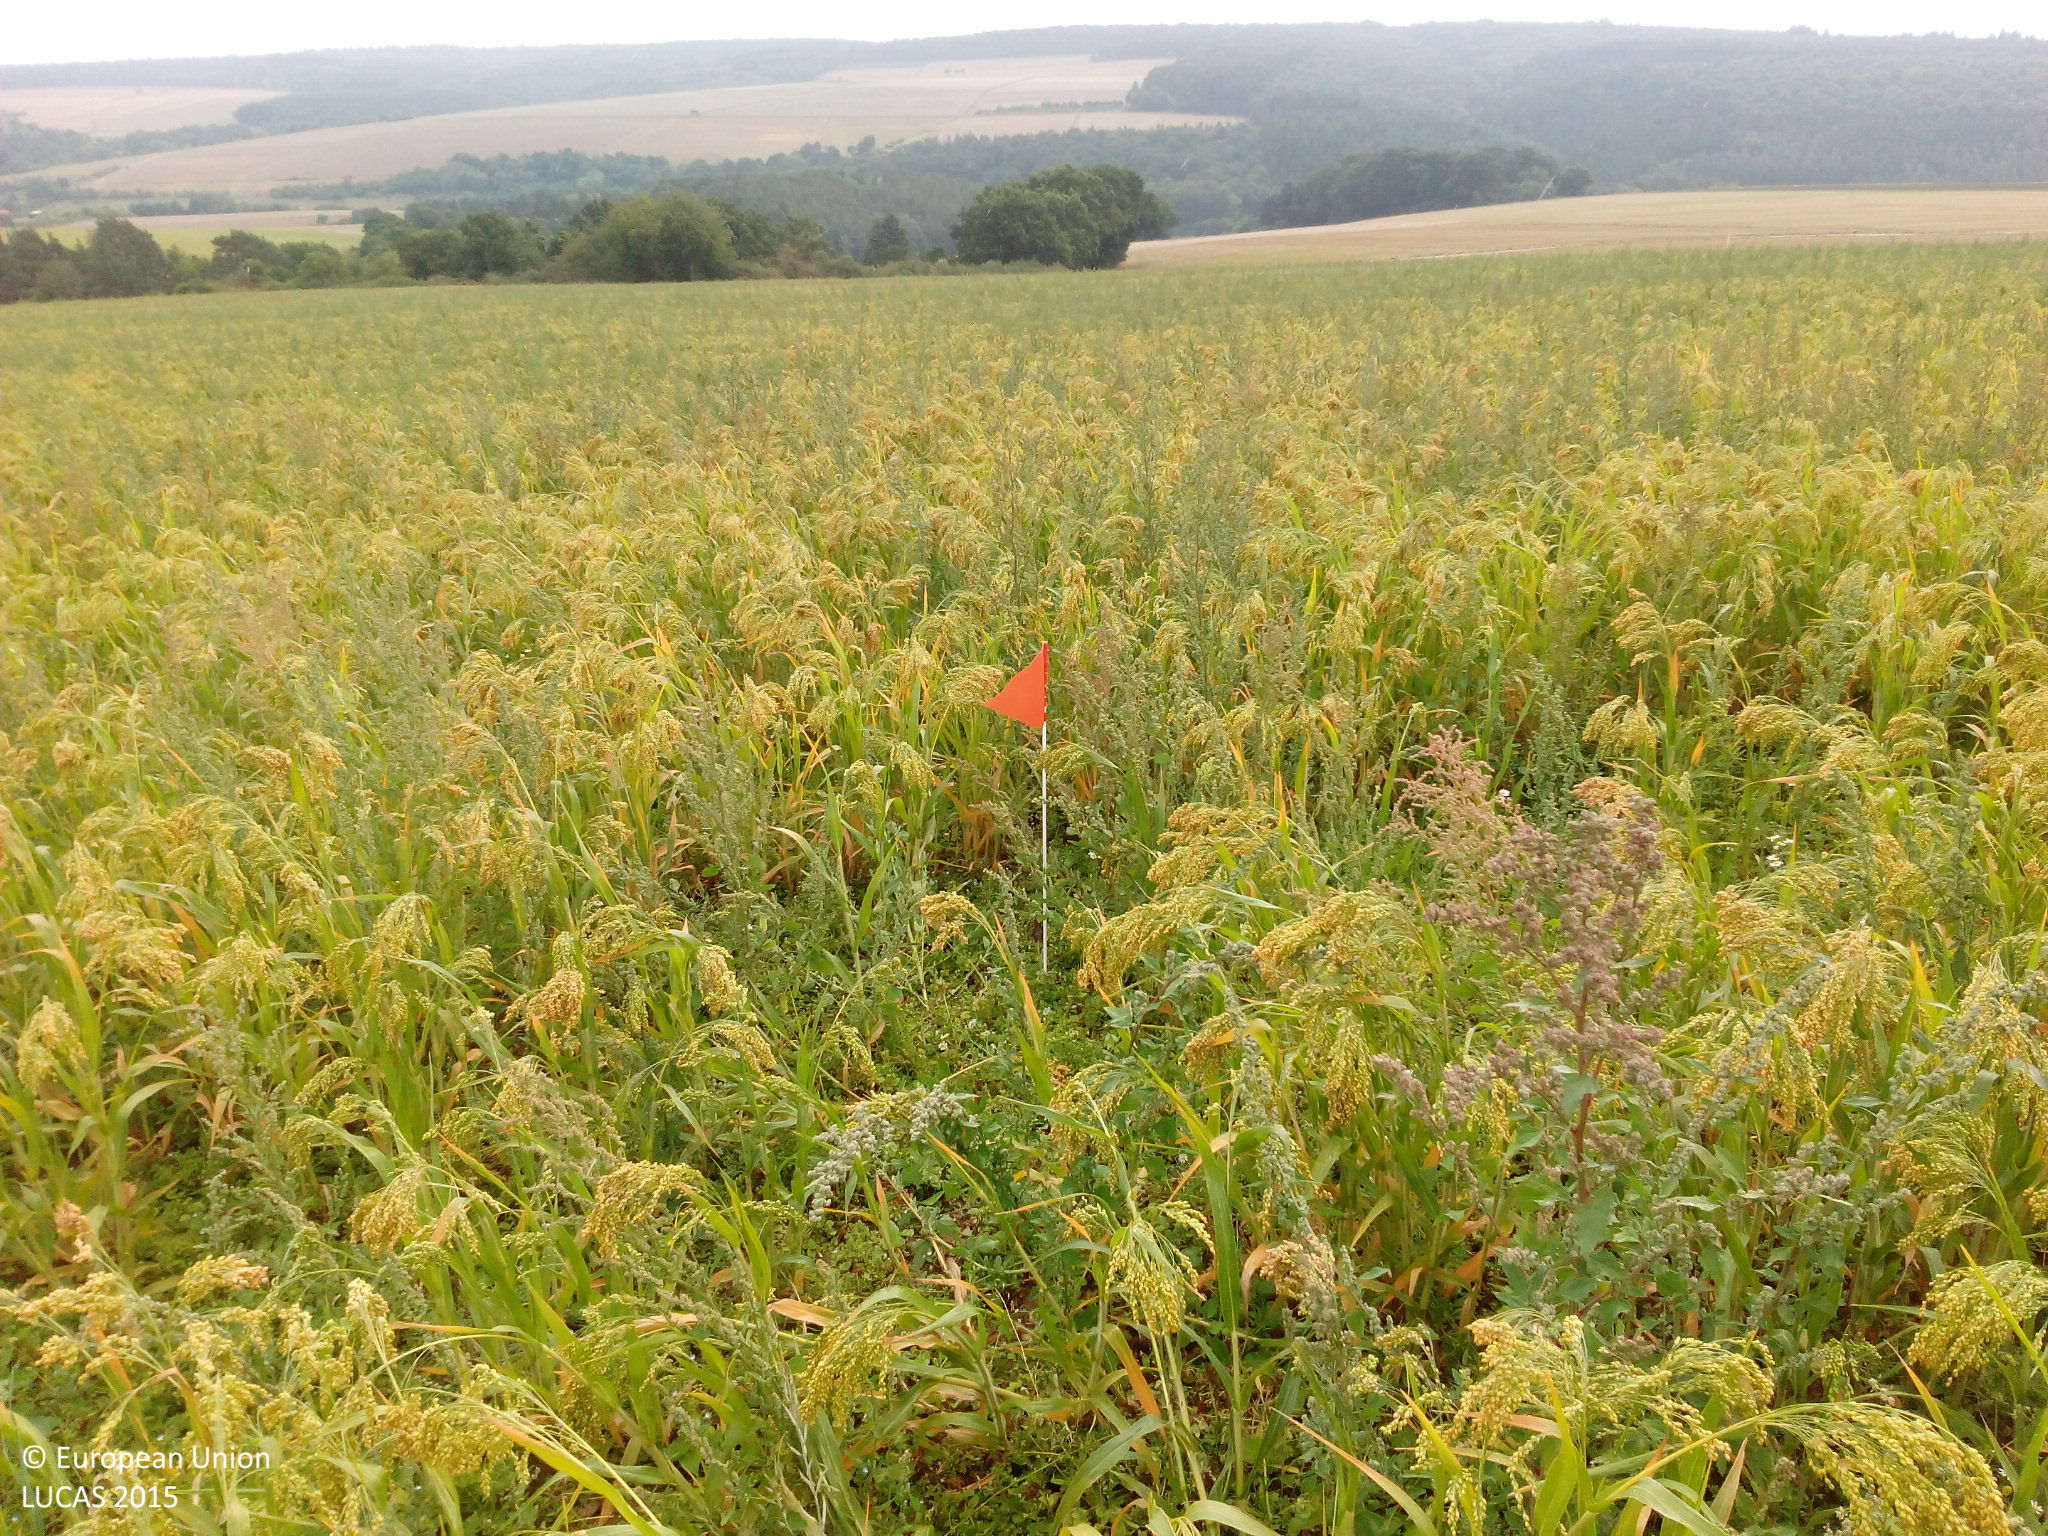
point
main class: Cropland
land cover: Other cereals
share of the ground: > 75 %
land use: Agriculture (excluding fallow land and kitchen gardens)
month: August
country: DE
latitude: 50.2409
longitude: 8.1355
